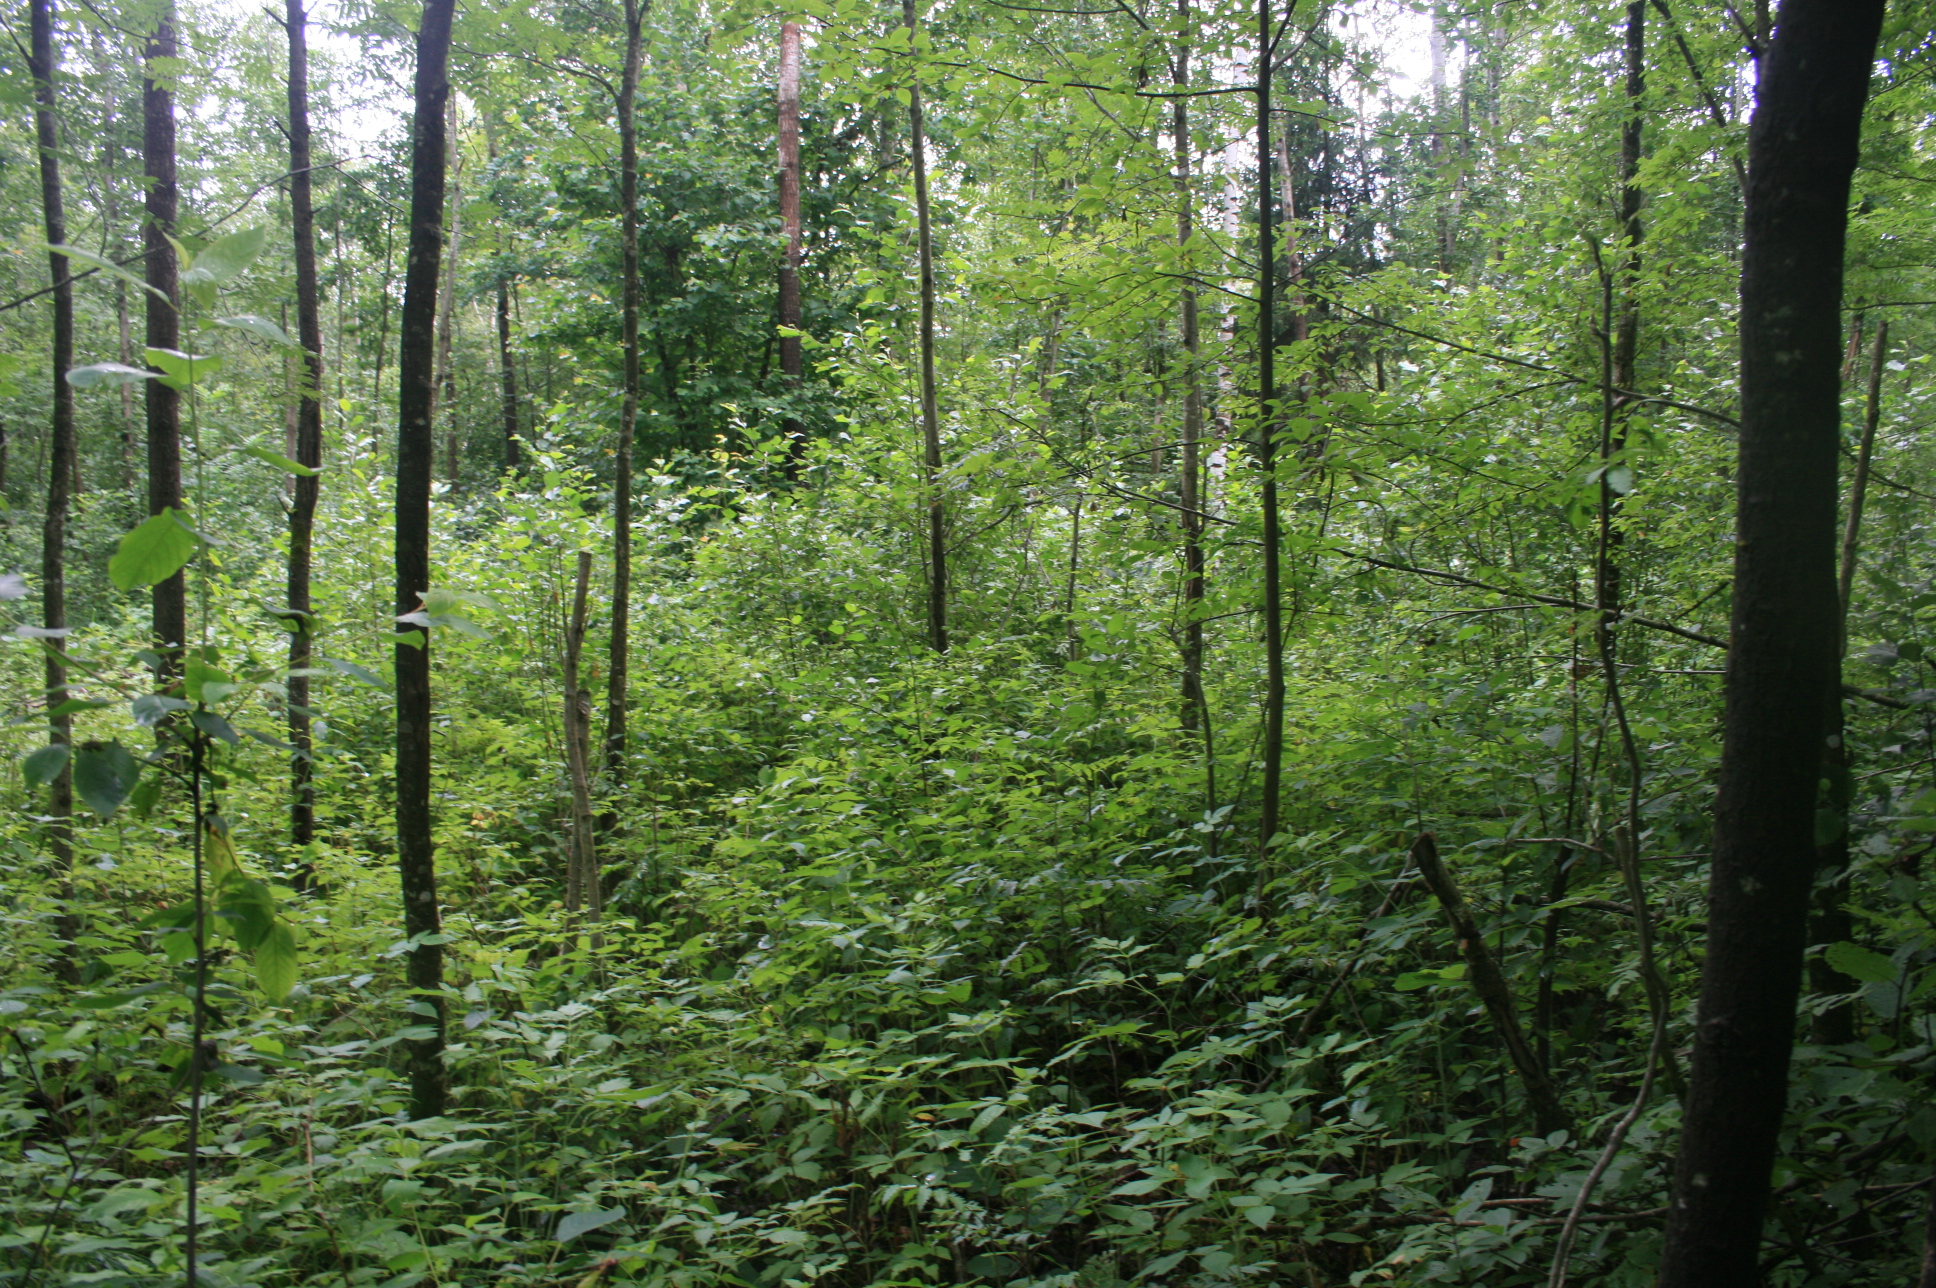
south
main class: Woodland
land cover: Broadleaved woodland
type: non-riverine alder, birch or aspen forest
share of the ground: > 75 %
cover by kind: broadleaved forest trees 90 %, herbaceous plants 10 %
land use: Forestry
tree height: > 5 m
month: July
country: LT
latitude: 55.9061
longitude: 21.2867
